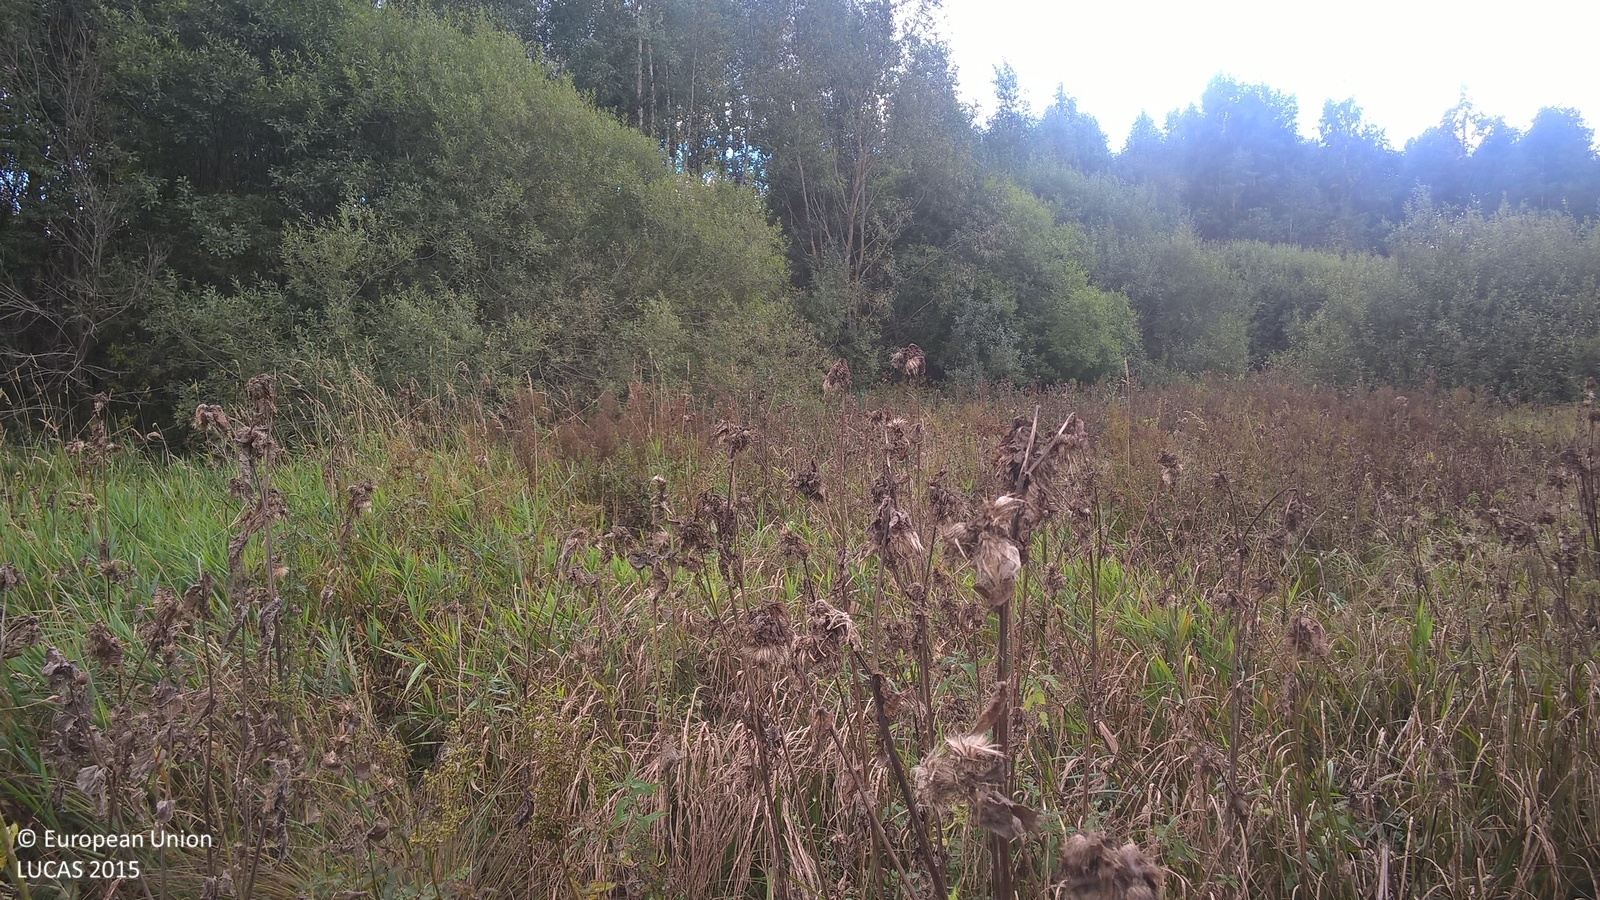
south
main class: Grassland
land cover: Spontaneously vegetated surfaces
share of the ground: > 75 %
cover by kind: herbaceous plants 95 %, shrubs 5 %
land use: Semi-natural and natural areas not in use
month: September
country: LV
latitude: 57.7172
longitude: 25.6456
